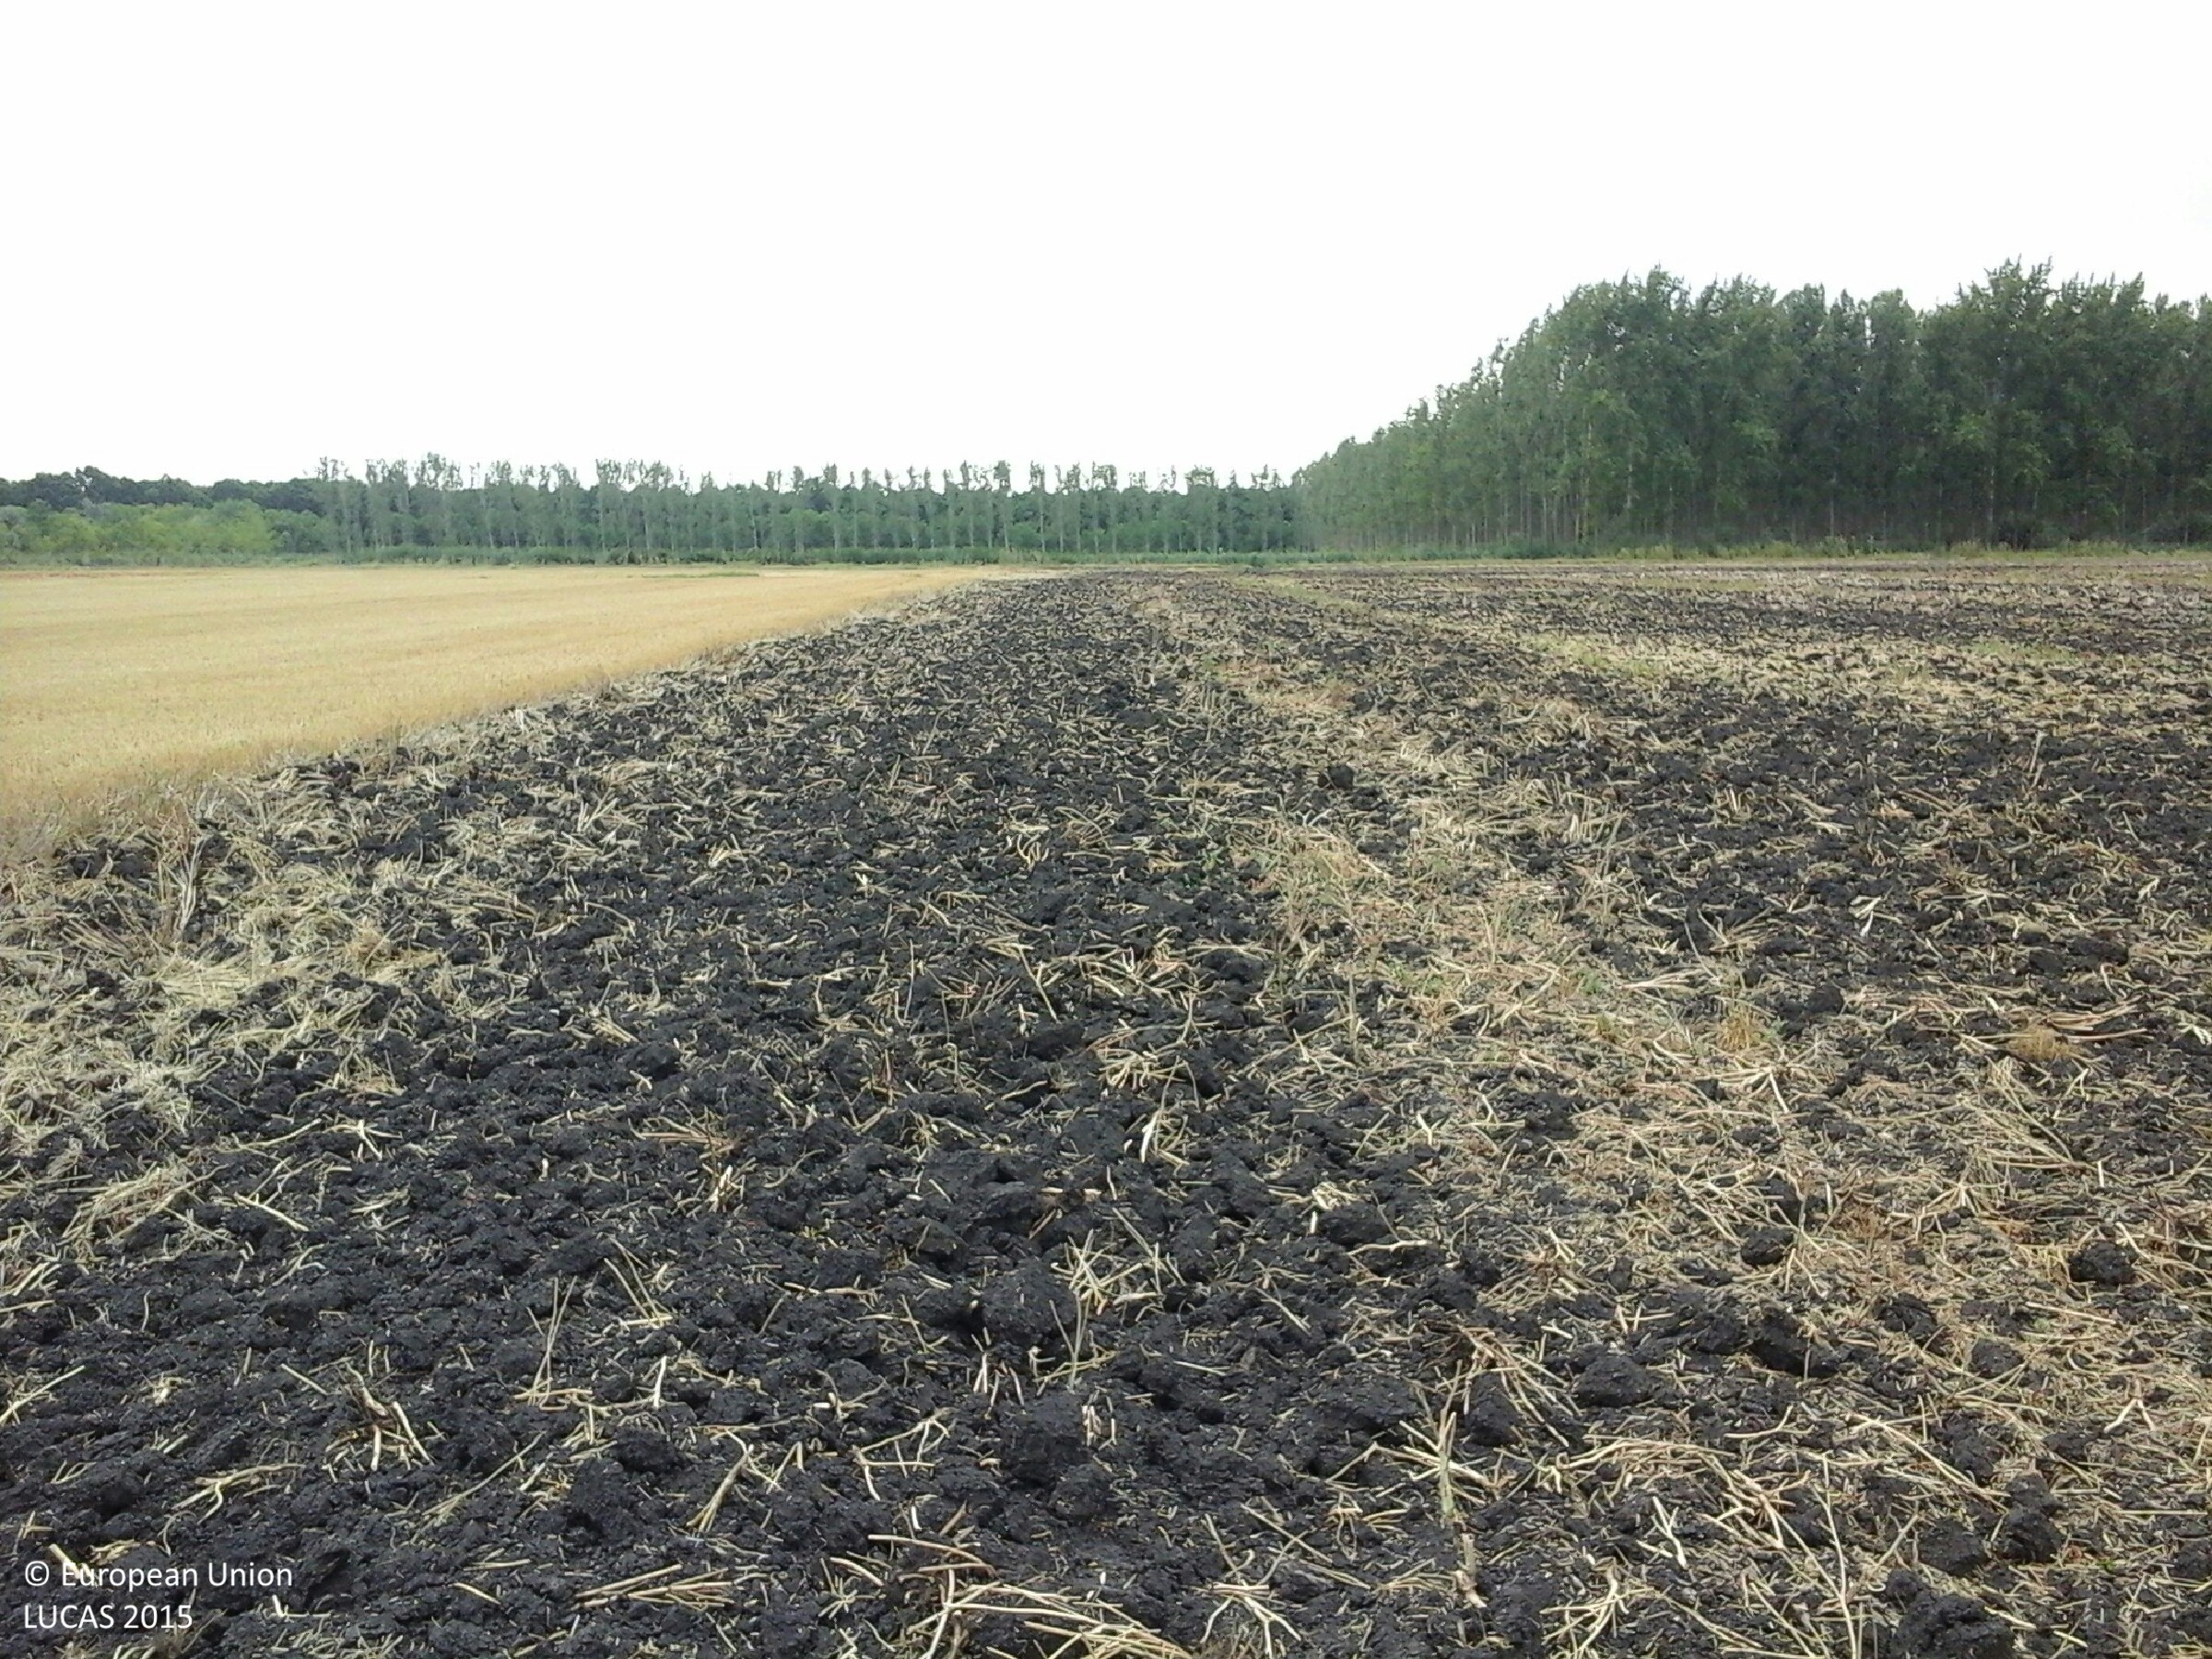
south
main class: Cropland
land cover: Rape and turnip rape
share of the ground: 50 - 75 %
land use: Agriculture (excluding fallow land and kitchen gardens)
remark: Harvested field
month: July
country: HU
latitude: 47.4235
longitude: 20.5700
